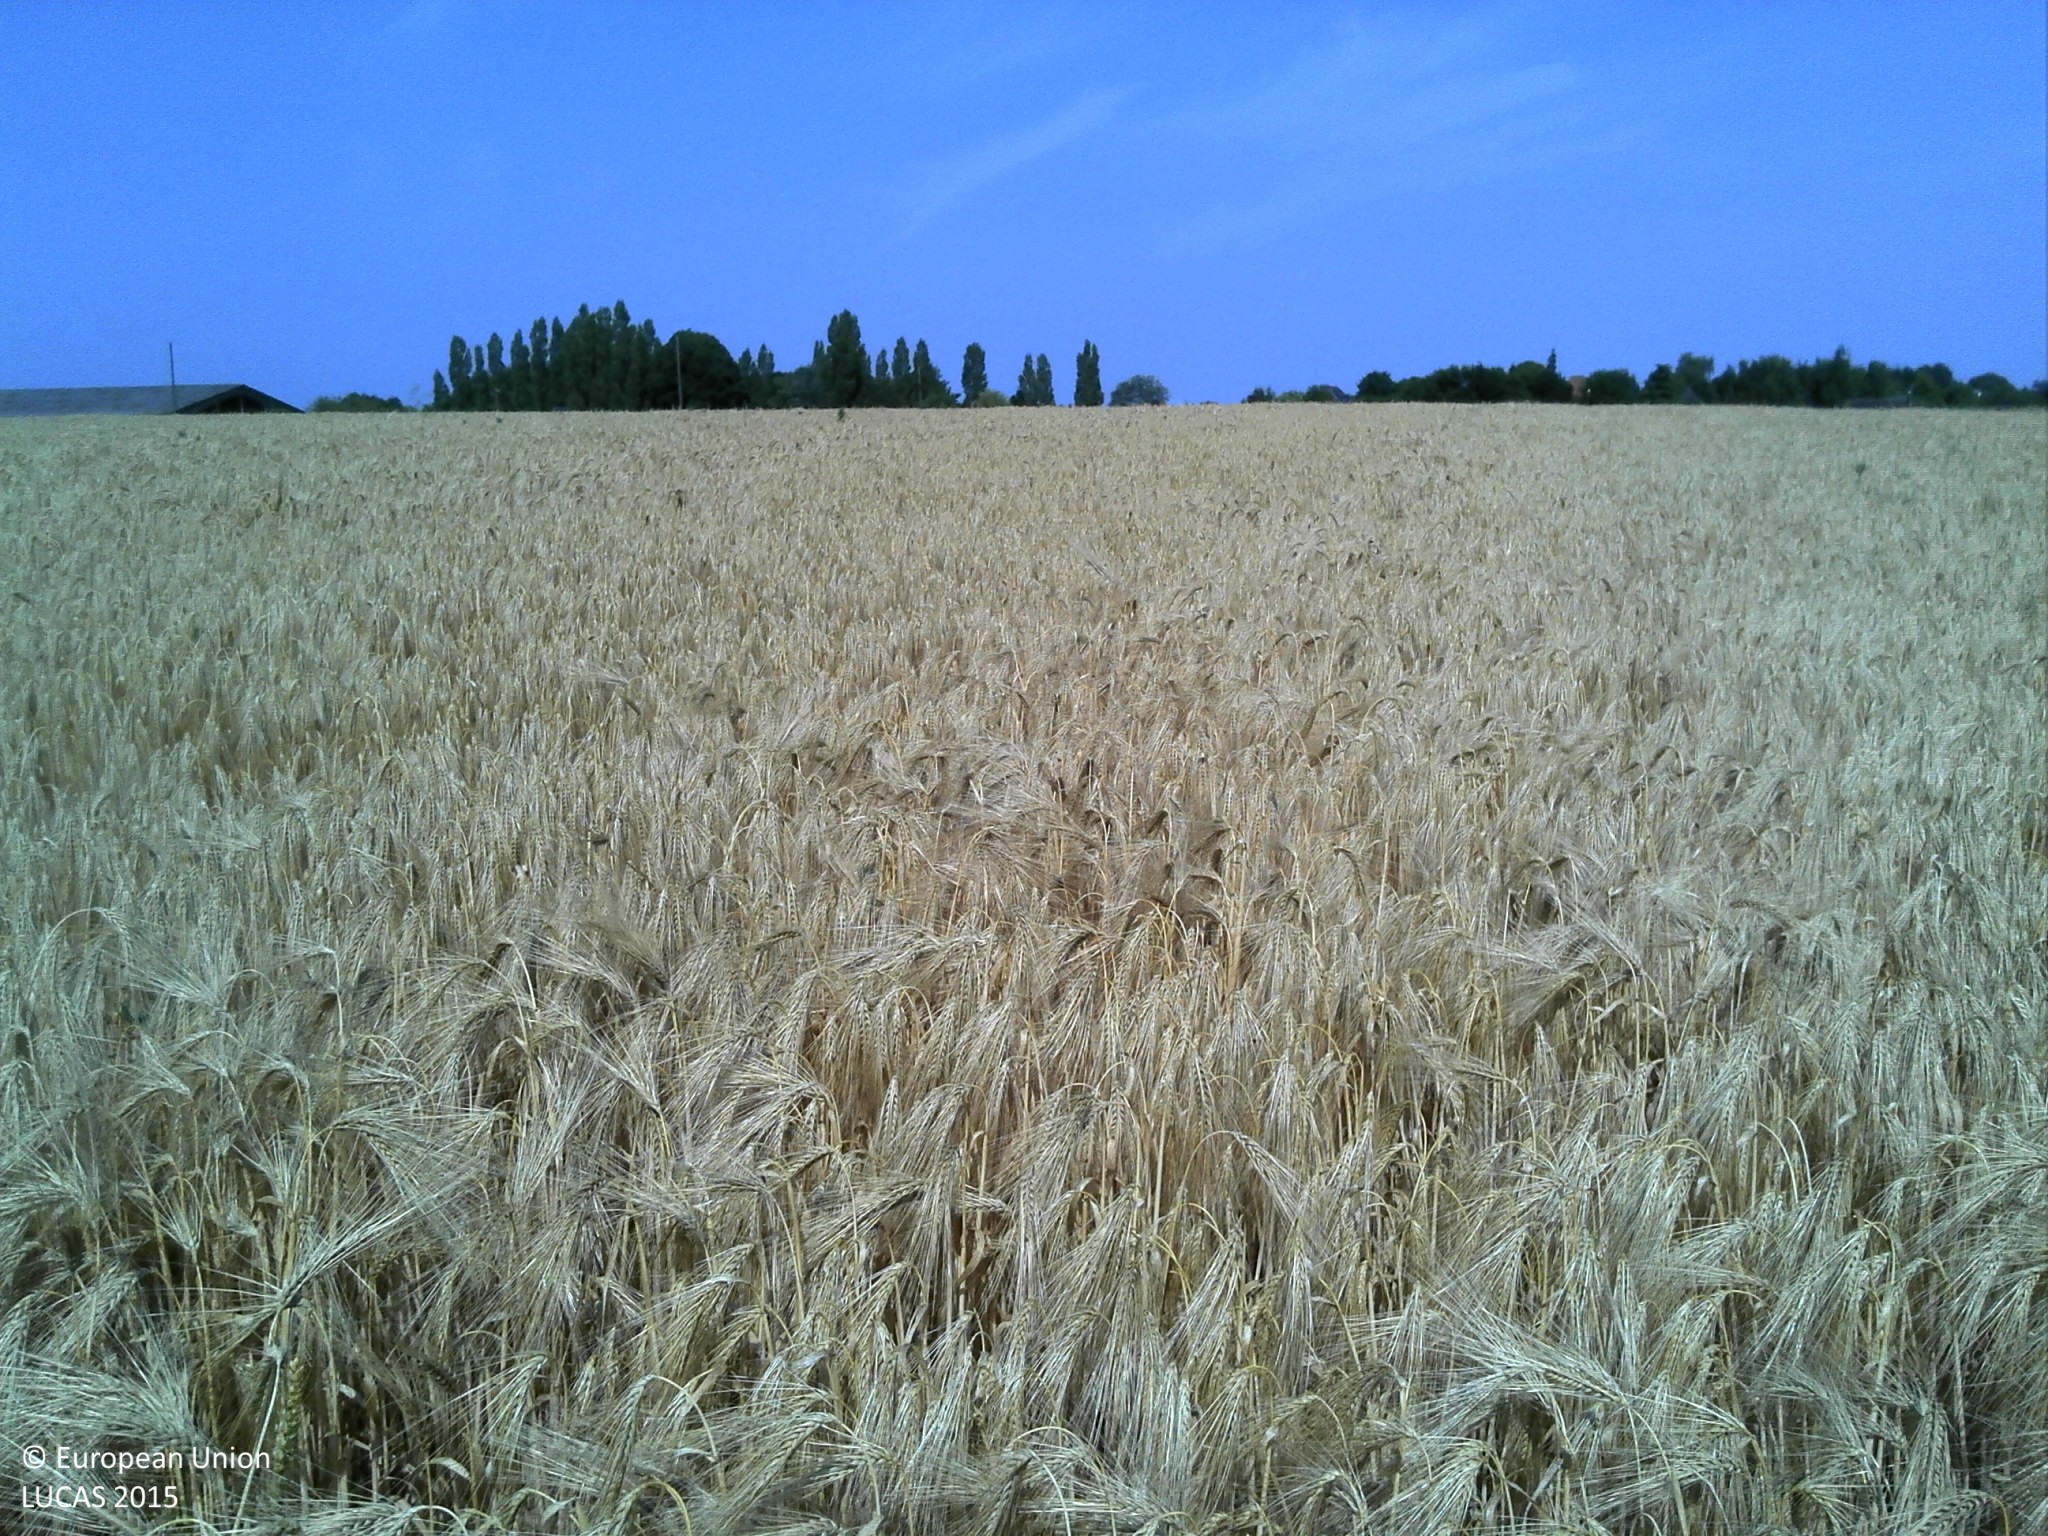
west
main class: Cropland
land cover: Barley
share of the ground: > 75 %
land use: Agriculture (excluding fallow land and kitchen gardens)
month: July
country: FR
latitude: 49.5184
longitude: 1.2080
